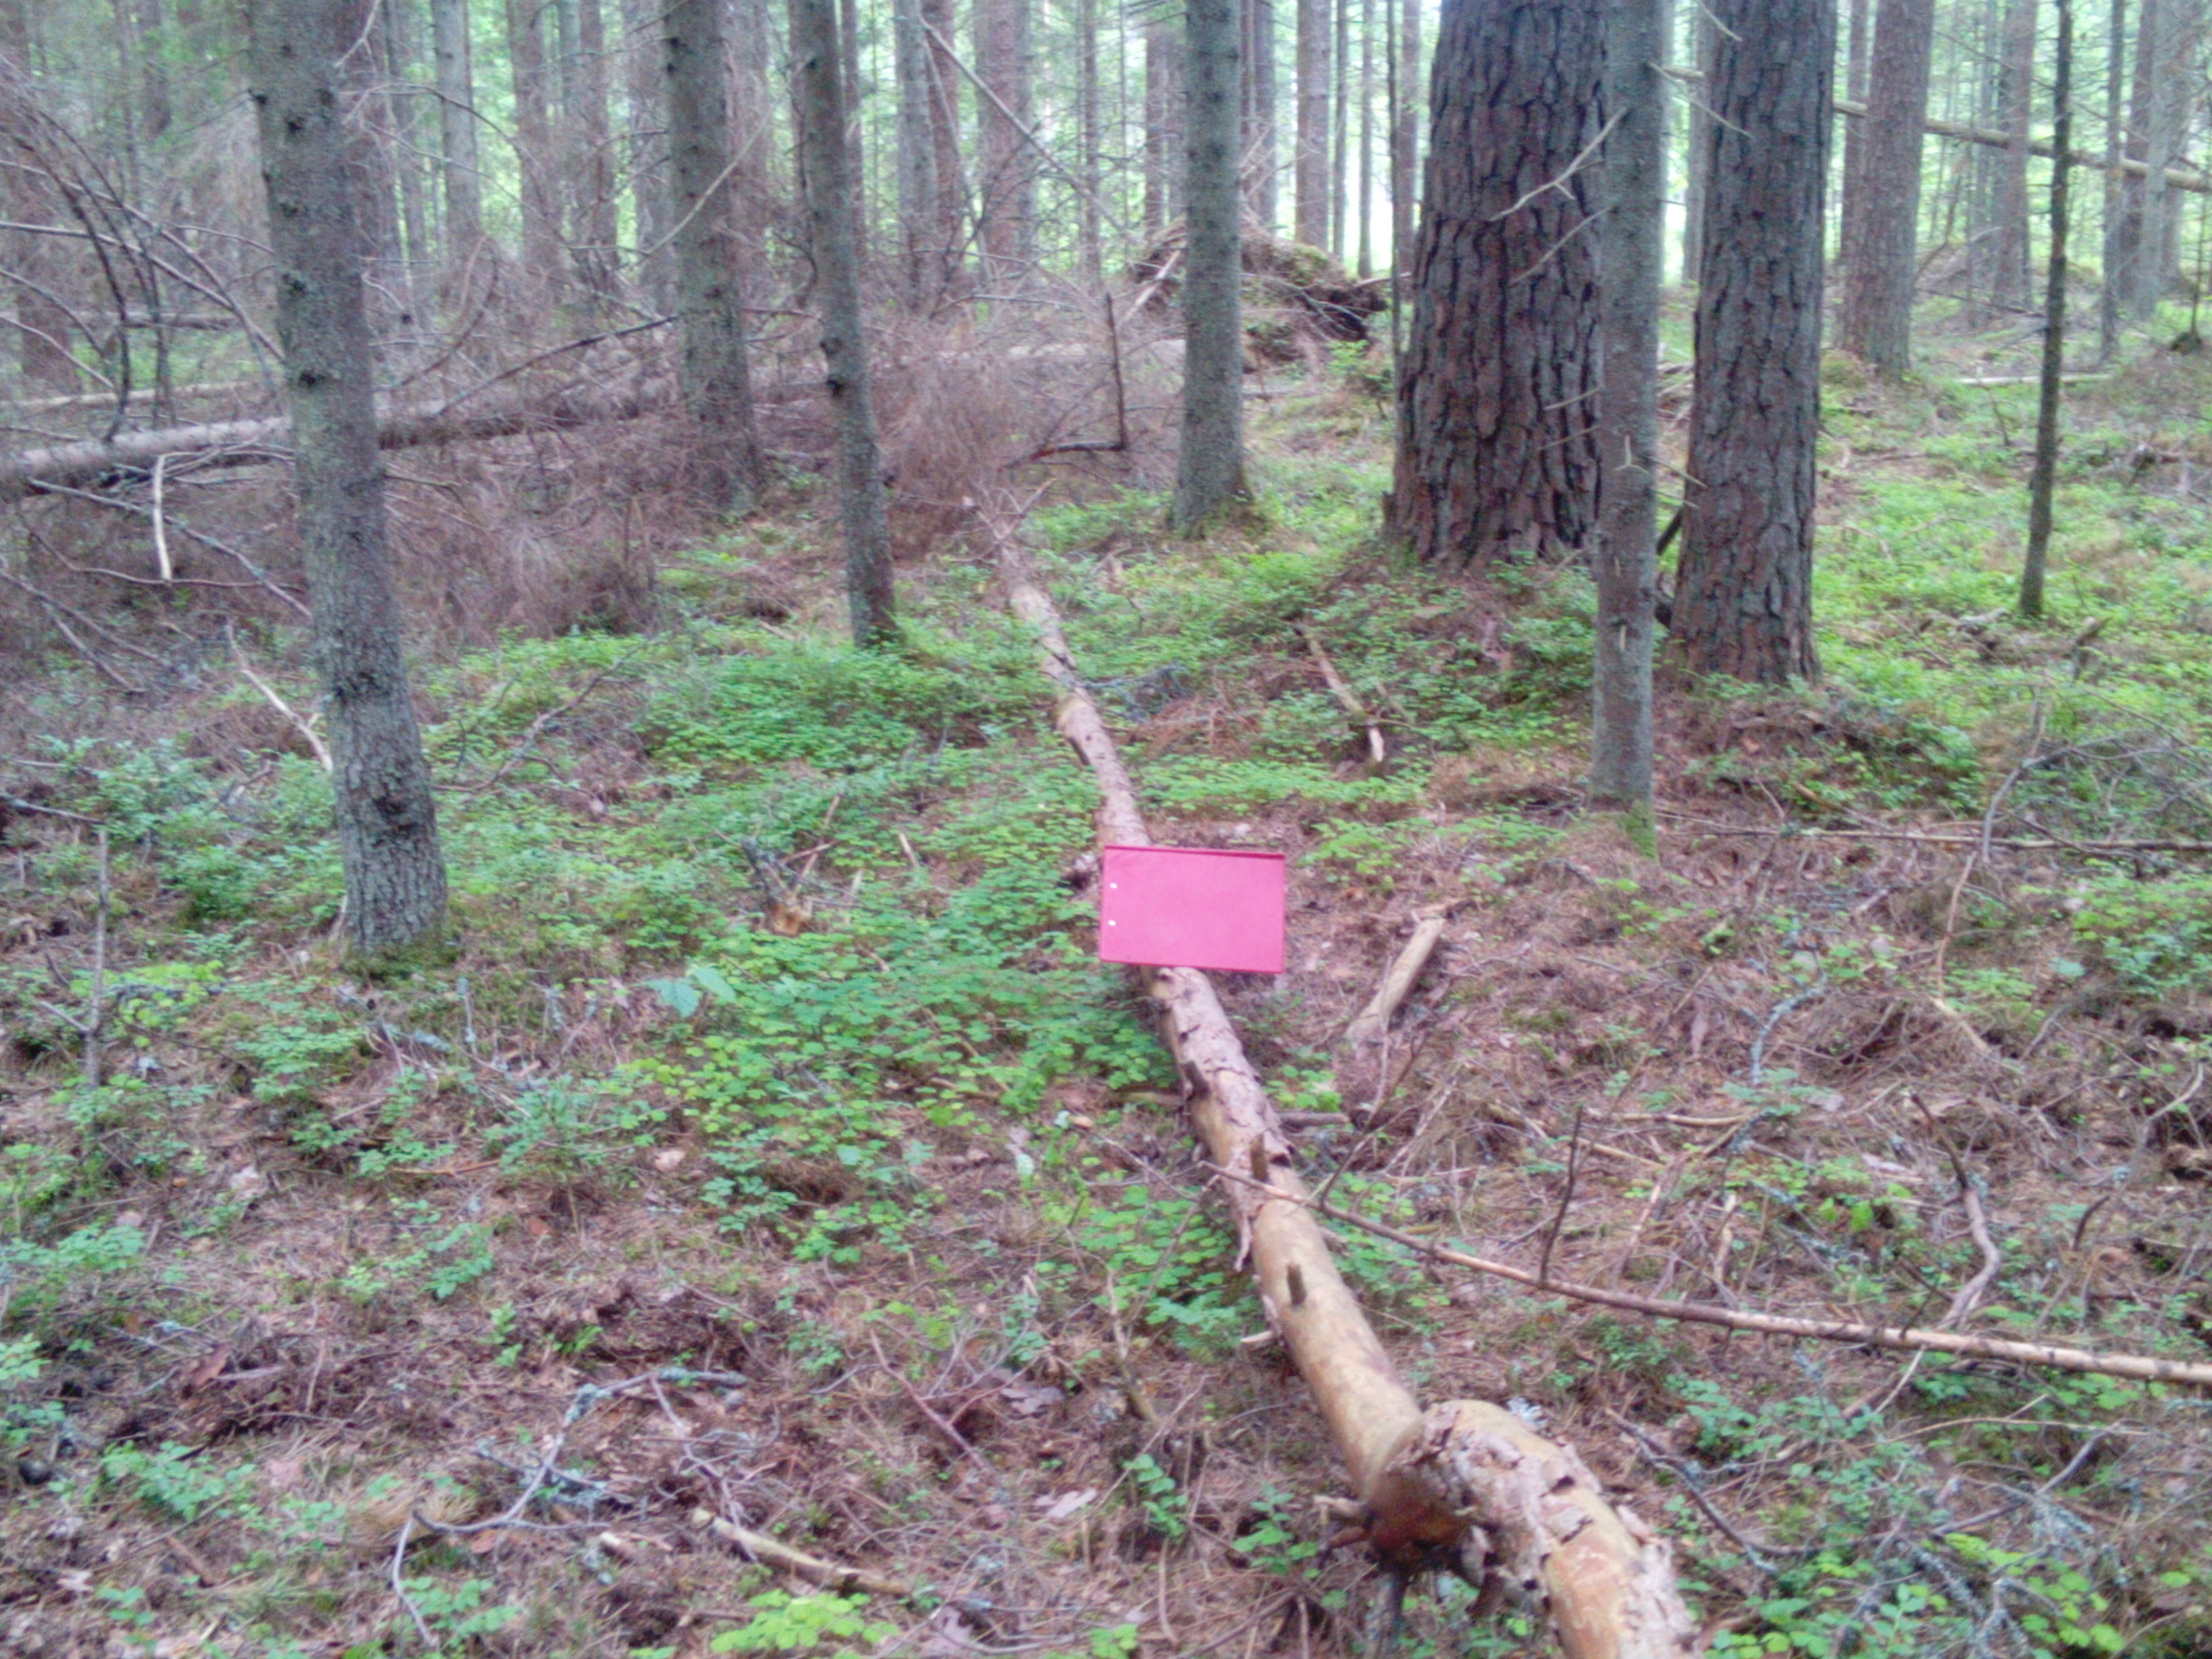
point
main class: Woodland
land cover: Other coniferous woodland
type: hemiboreal forest and nemoral coniferous forest and mixed broadleaved-coniferous forest
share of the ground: > 75 %
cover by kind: coniferous forest trees 85 %, herbaceous plants 10 %, lichens and mosses 5 %
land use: Forestry
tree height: > 5 m
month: June
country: LV
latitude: 56.8180
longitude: 21.4592
